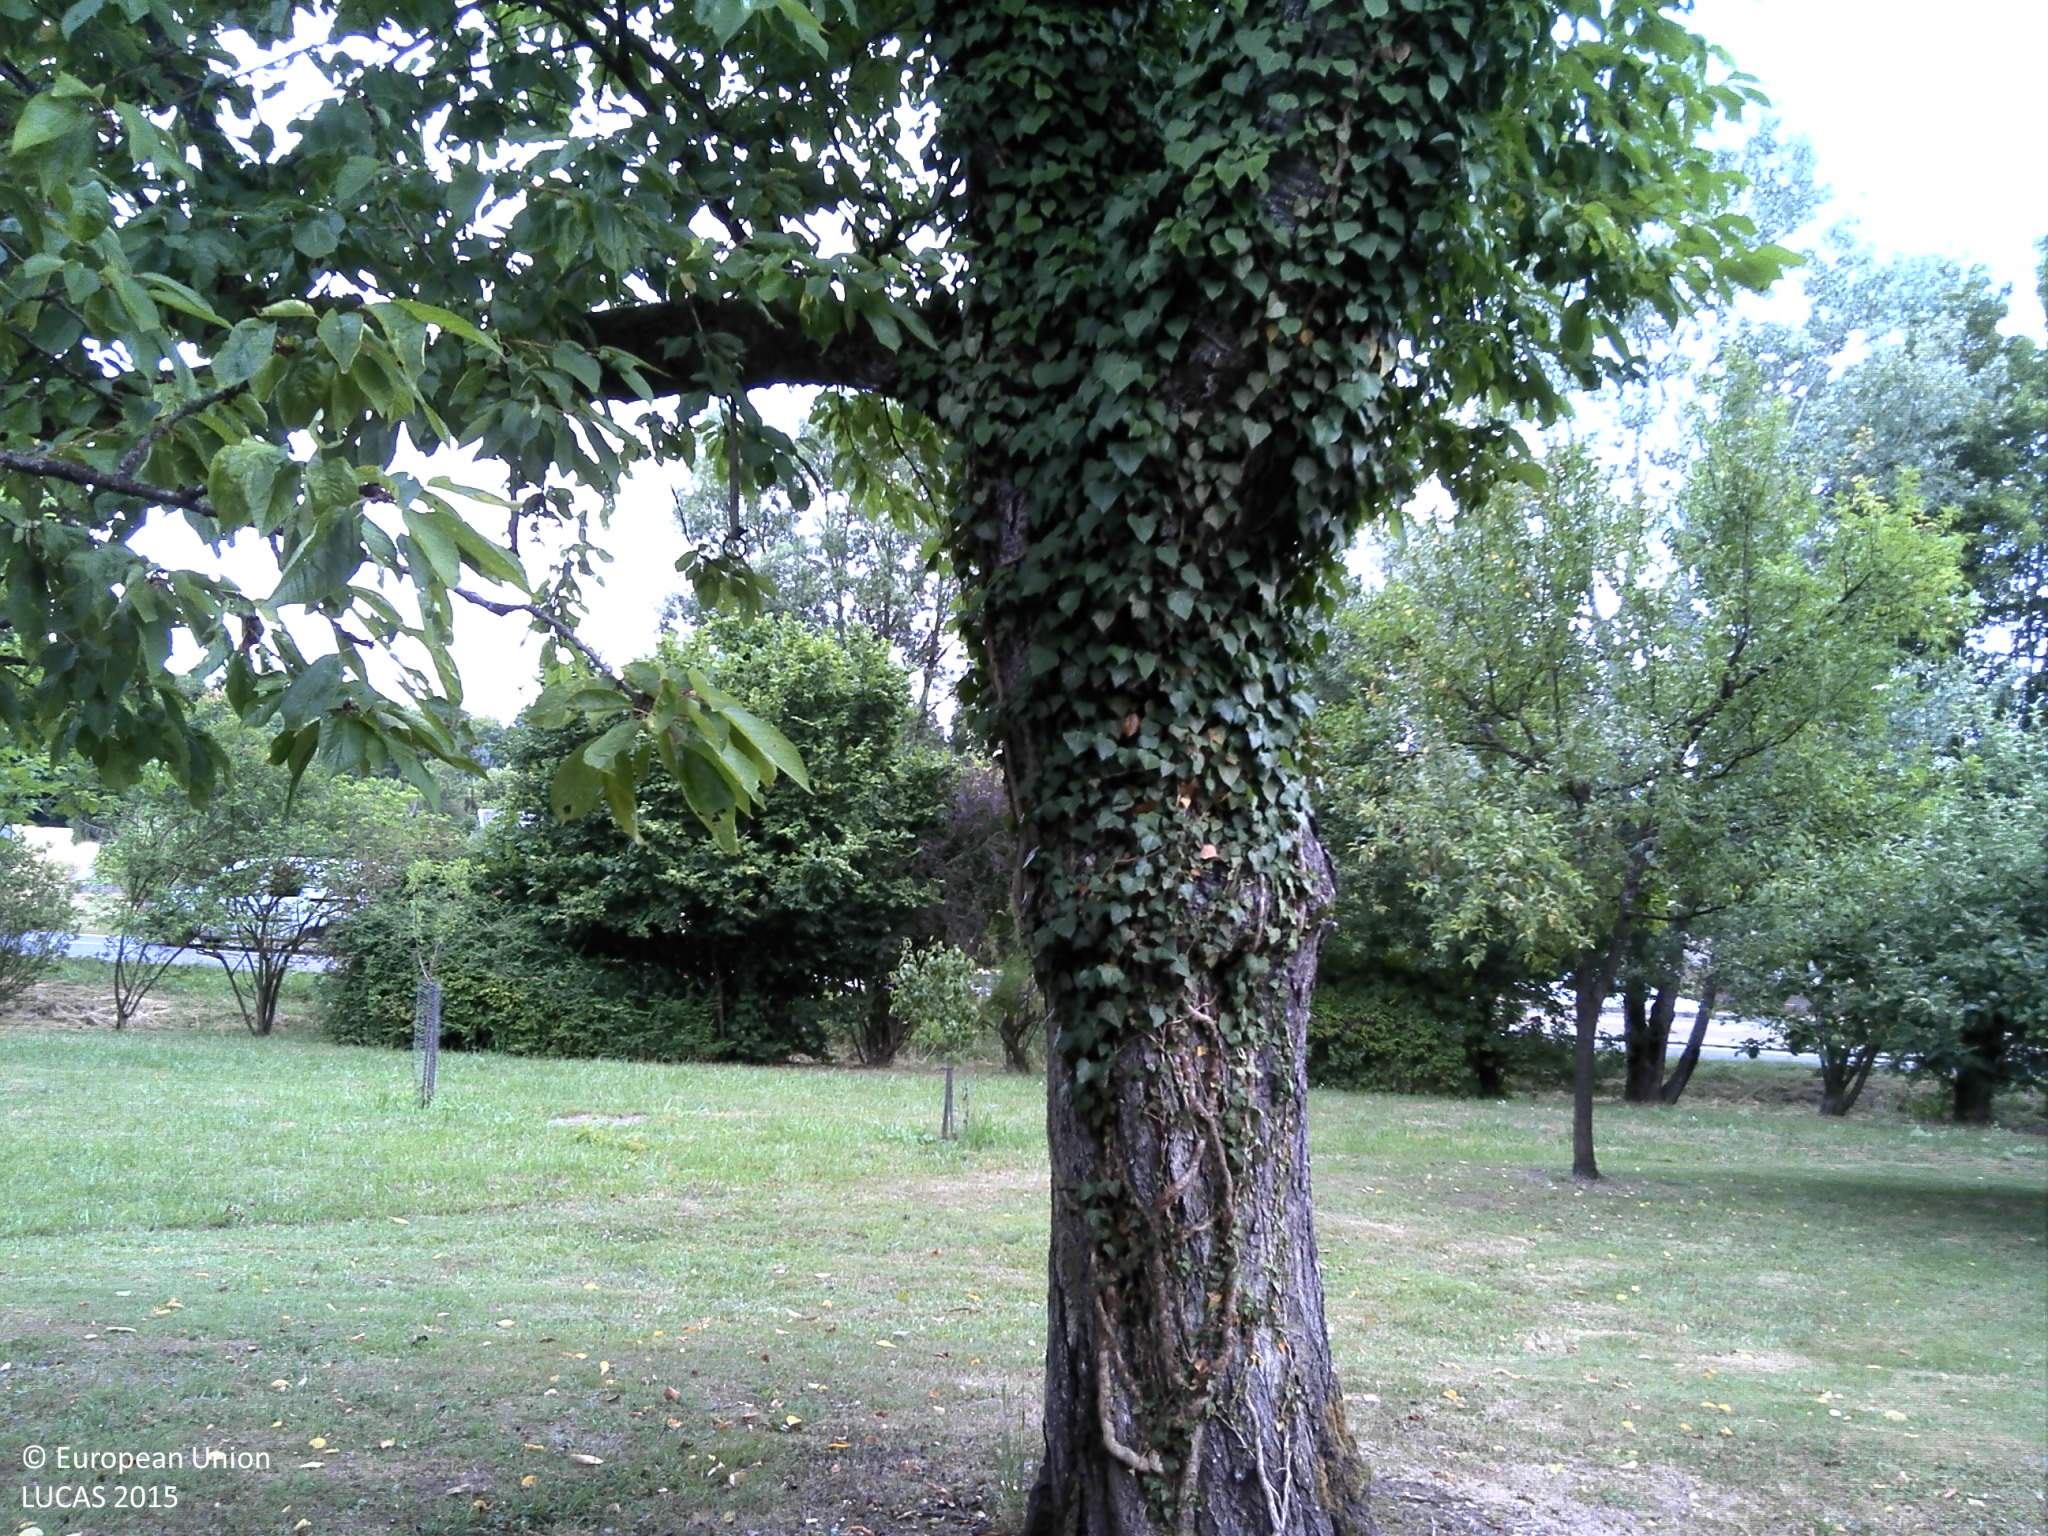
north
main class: Grassland
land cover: Grassland with sparse tree/shrub cover
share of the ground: > 75 %
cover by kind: herbaceous plants 95 %, broadleaved forest trees 5 %
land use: Residential
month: July
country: FR
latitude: 49.3006
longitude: 6.4381
